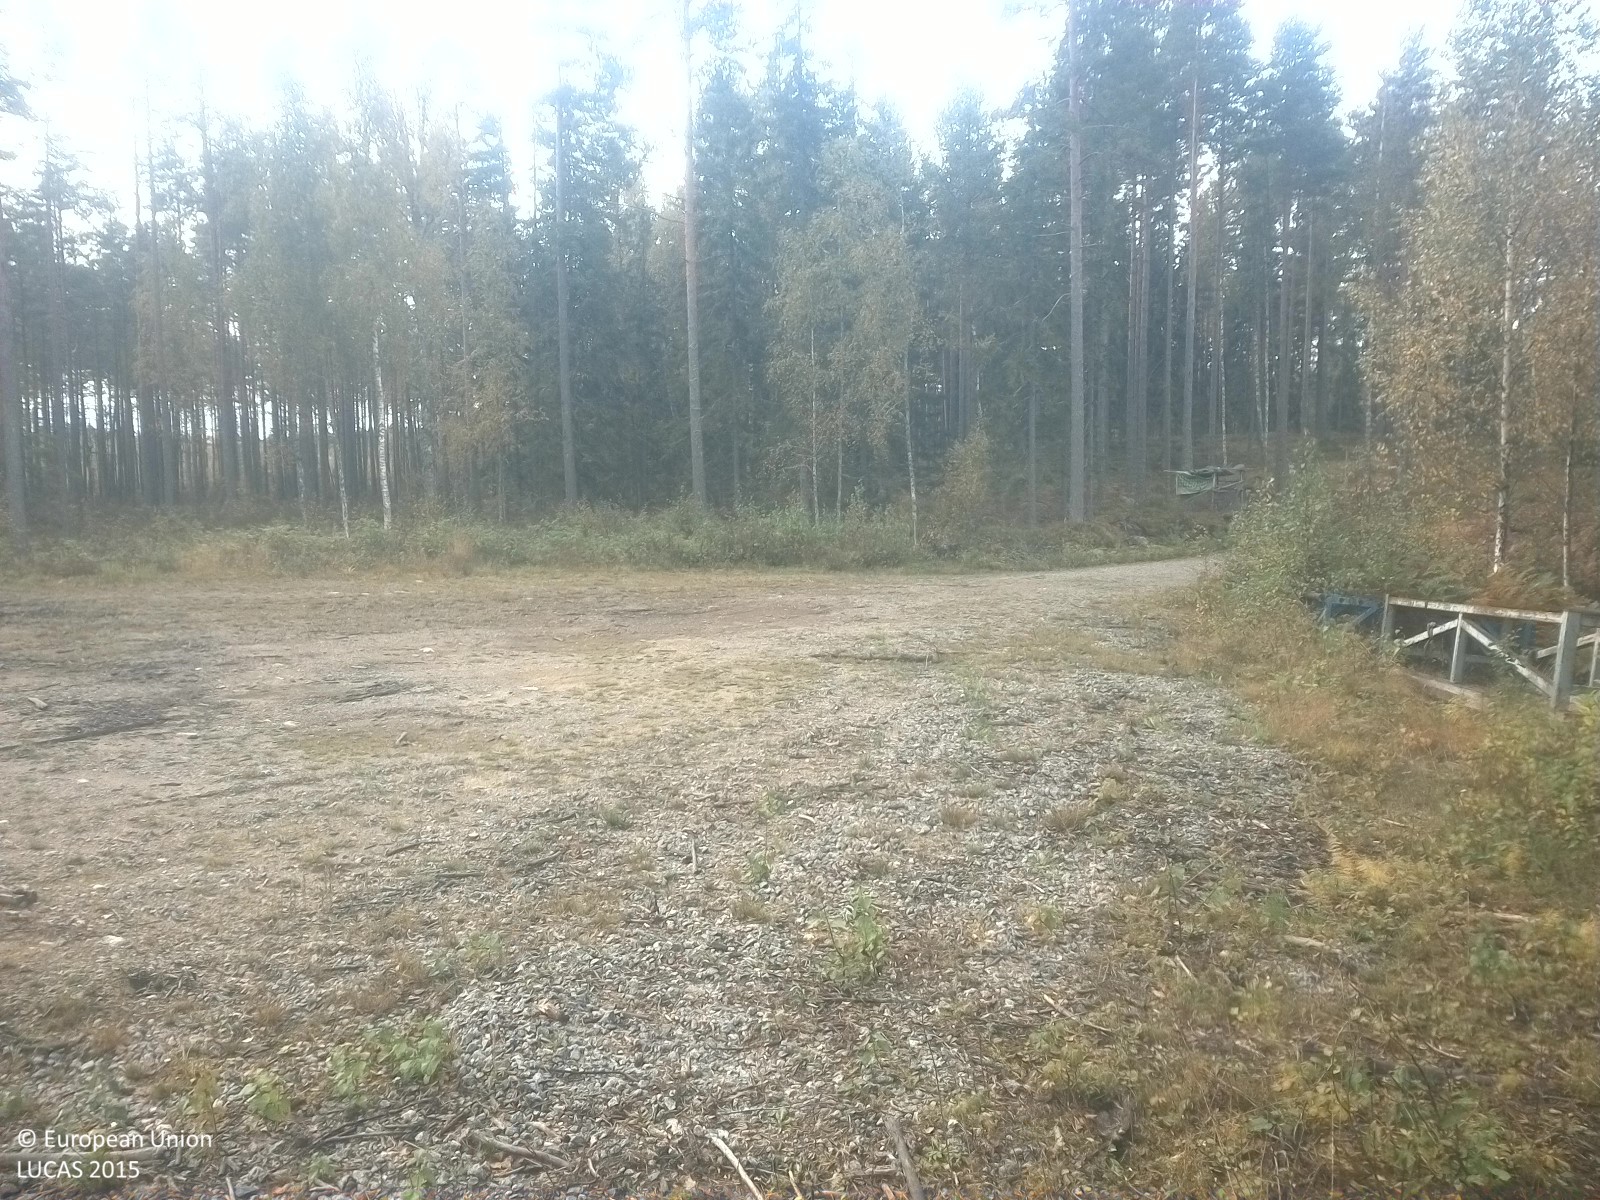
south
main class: Shrubland
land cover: Shrubland with sparse tree cover
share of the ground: > 75 %
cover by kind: shrubs 80 %, herbaceous plants 15 %, broadleaved forest trees 5 %
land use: Semi-natural and natural areas not in use
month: September
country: SE
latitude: 58.8565
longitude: 15.6967
